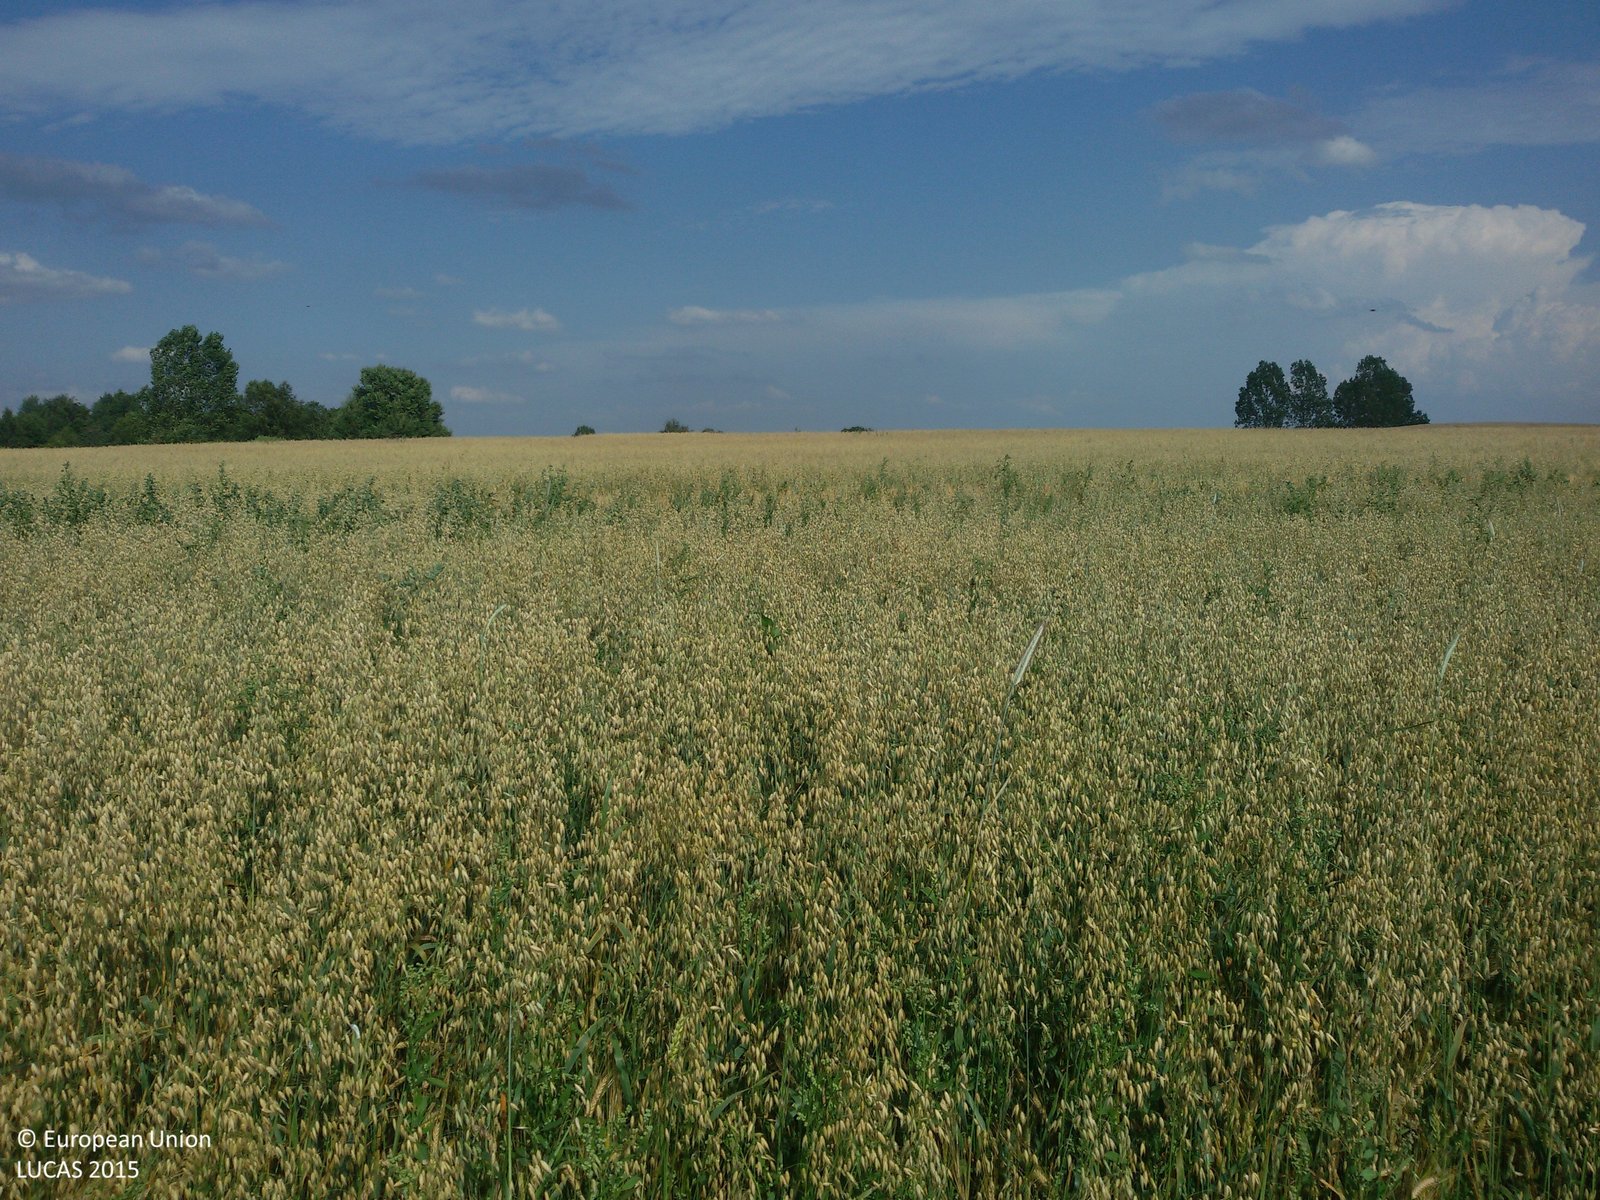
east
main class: Grassland
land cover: Grassland without tree/shrub cover
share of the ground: > 75 %
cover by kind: herbaceous plants 100 %
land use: Agriculture (excluding fallow land and kitchen gardens)
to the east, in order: Grassland without tree/shrub cover; Oats; Barley; Grassland without tree/shrub cover; Common wheat; Grassland without tree/shrub cover
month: July
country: PL
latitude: 53.3718
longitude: 17.7236
